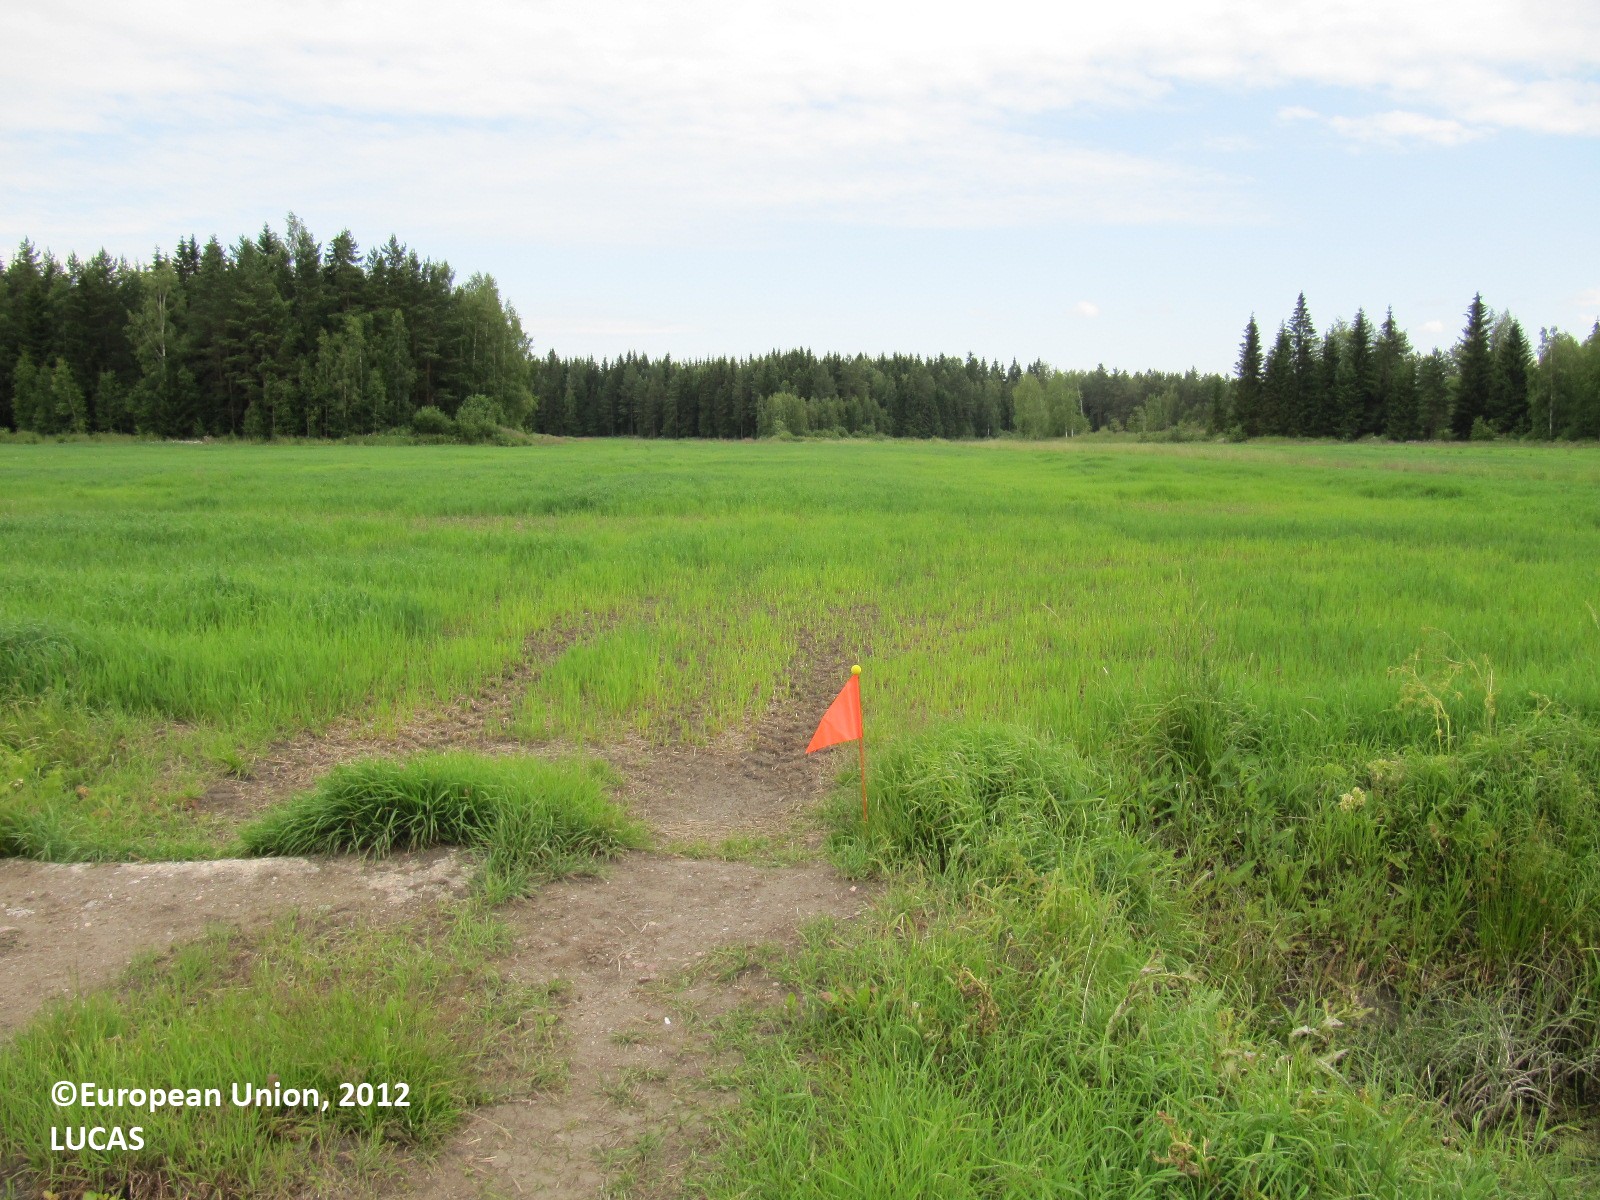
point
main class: Cropland
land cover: Oats
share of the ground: 50 - 75 %
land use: Agriculture (excluding fallow land and kitchen gardens)
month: July
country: FI
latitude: 60.9057
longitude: 23.4492
